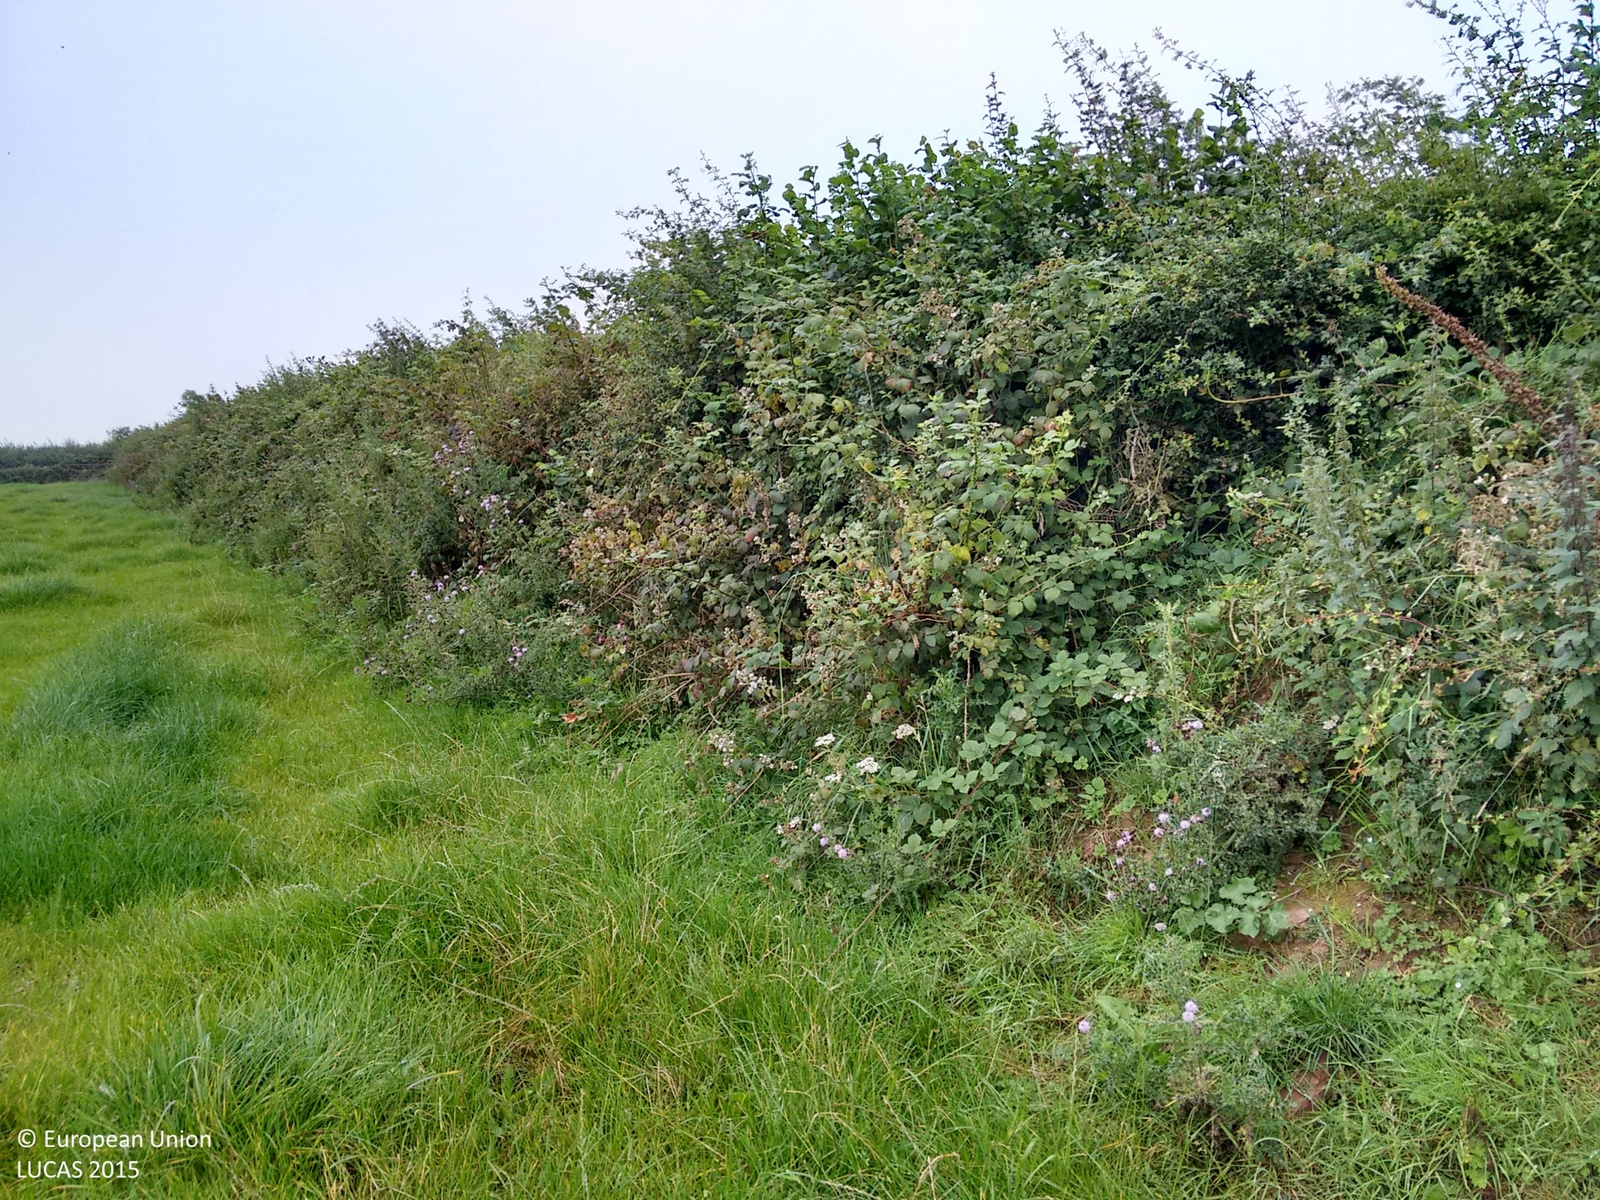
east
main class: Grassland
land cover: Grassland without tree/shrub cover
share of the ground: > 75 %
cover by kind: herbaceous plants 100 %
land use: Agriculture (excluding fallow land and kitchen gardens)
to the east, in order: Grassland without tree/shrub cover; Managed hedges; Grassland without tree/shrub cover; Managed hedges; Temporary grasslands
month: August
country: GB
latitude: 51.7908
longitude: -4.6506
